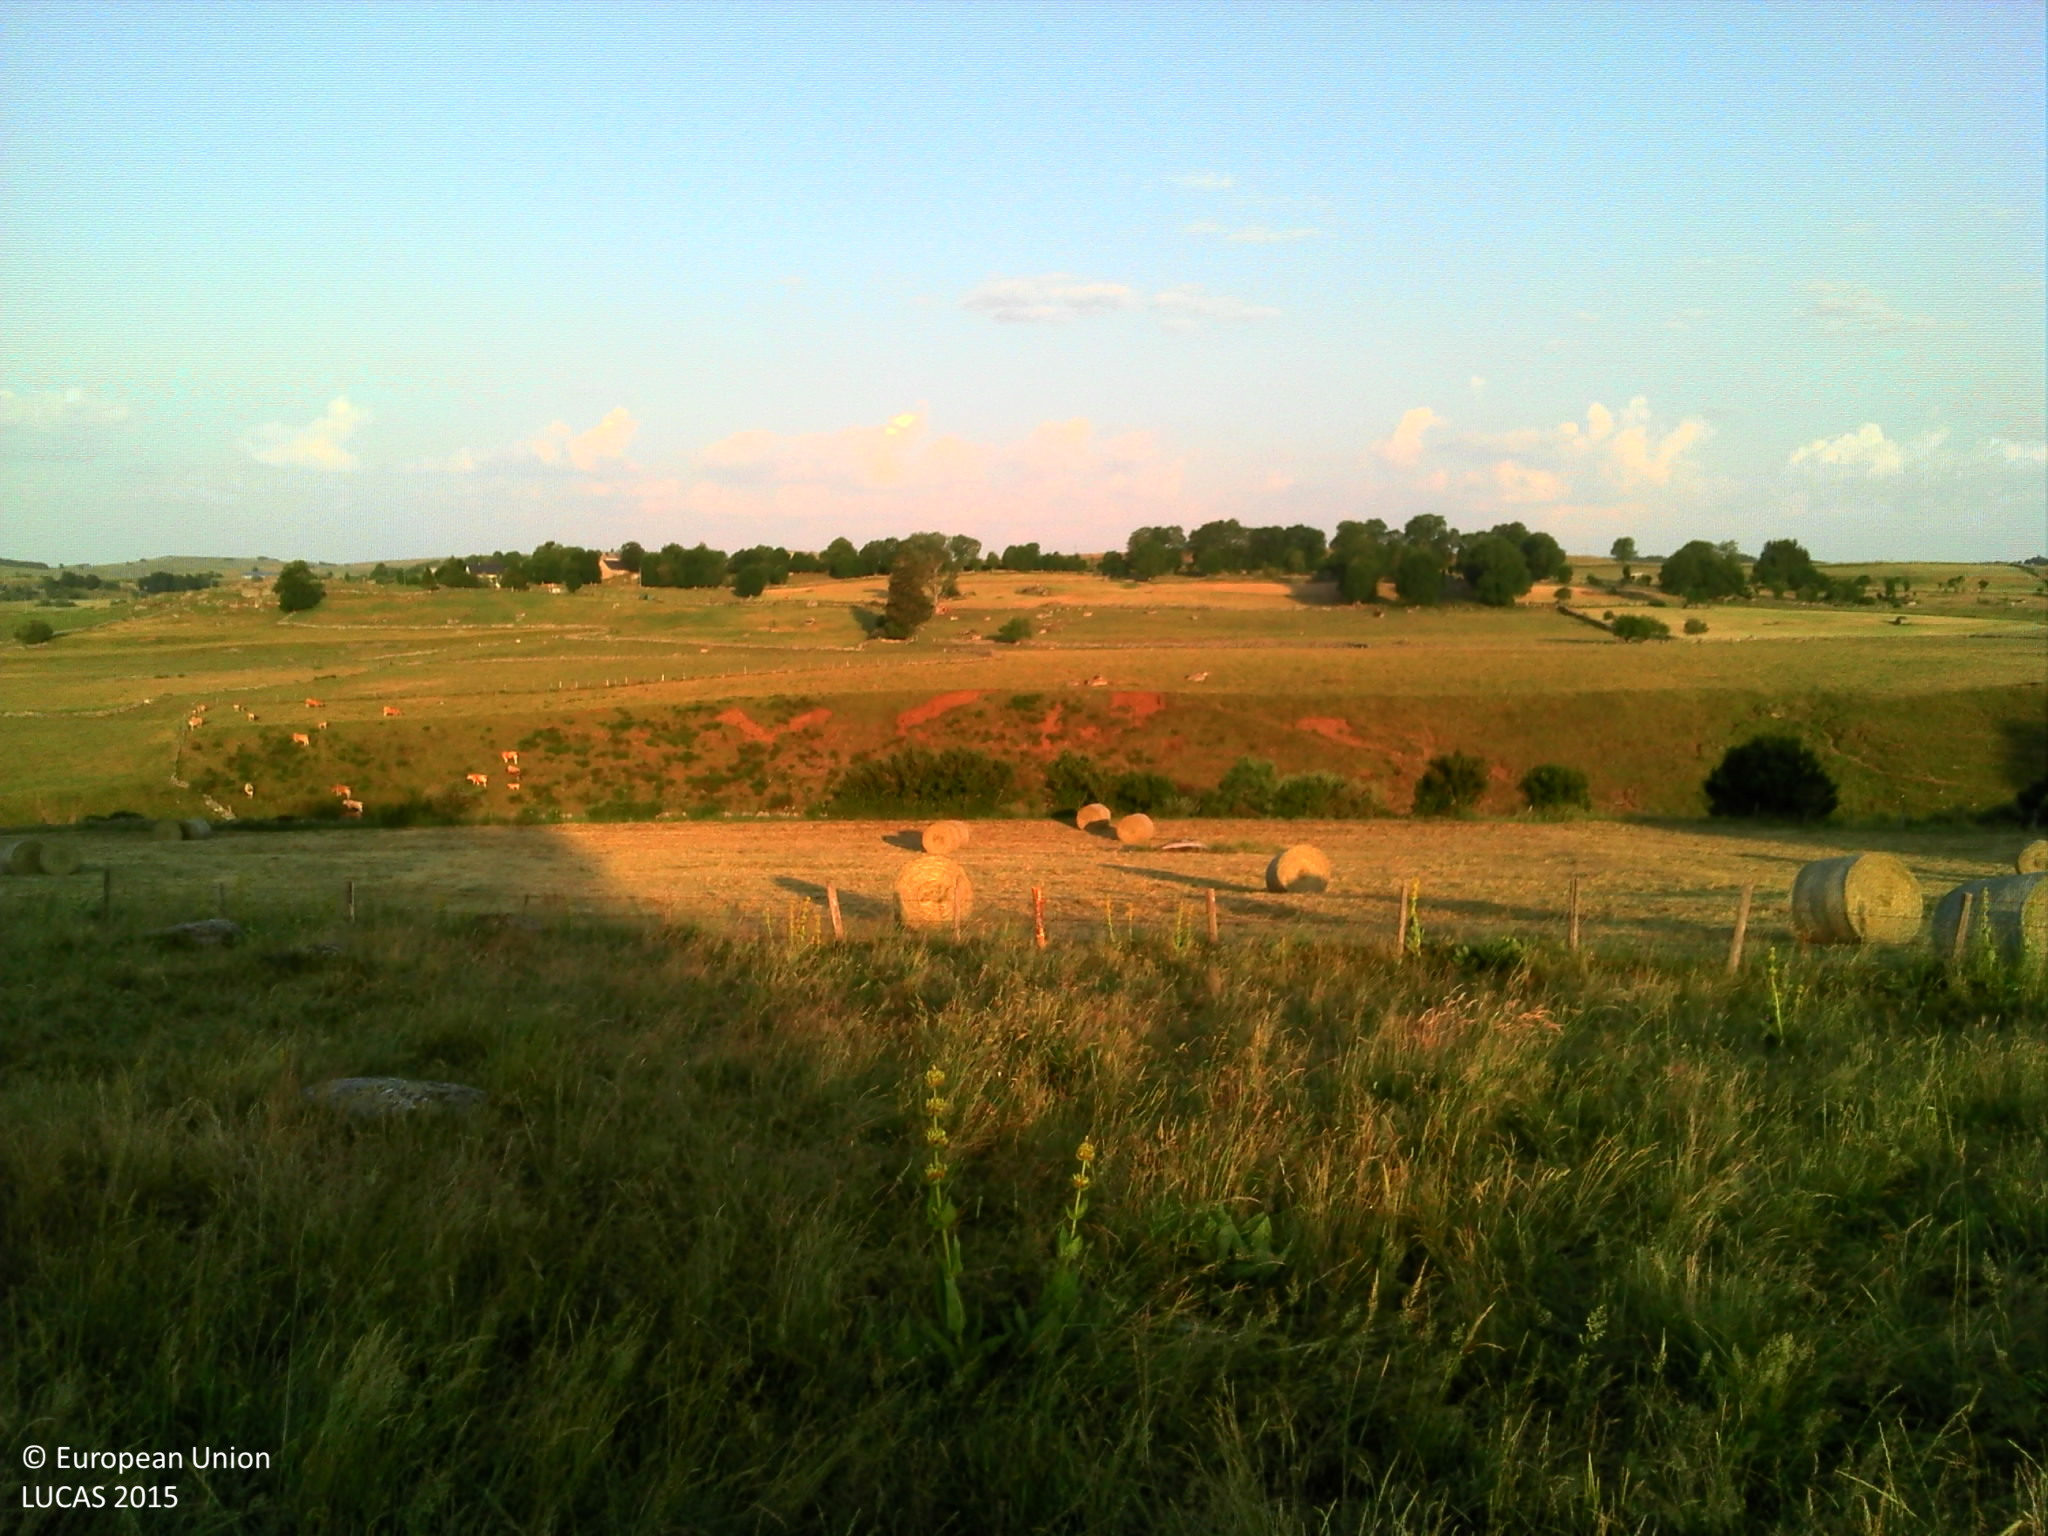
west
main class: Grassland
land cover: Grassland without tree/shrub cover
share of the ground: > 75 %
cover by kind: herbaceous plants 100 %
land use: Agriculture (excluding fallow land and kitchen gardens)
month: July
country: FR
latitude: 44.7306
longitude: 3.0206
